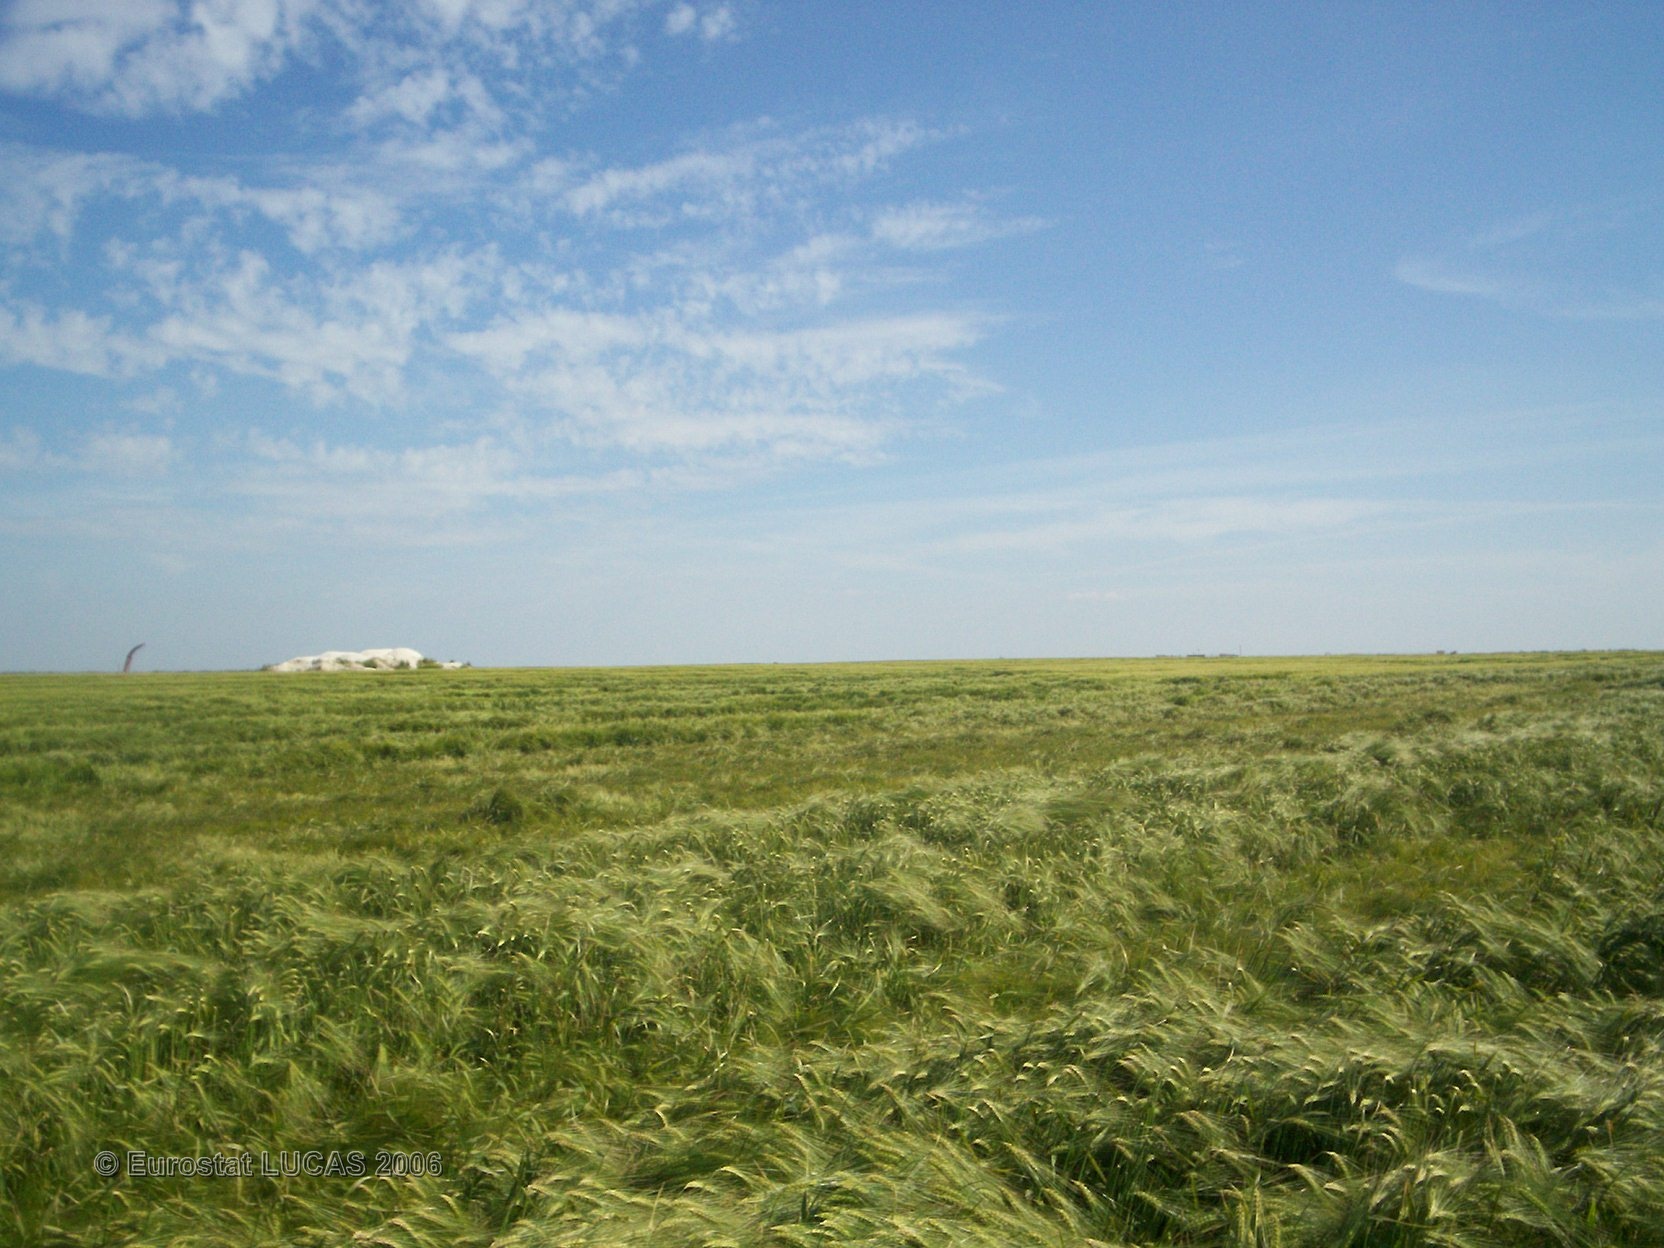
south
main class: Cropland
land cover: Barley
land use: Agriculture (excluding fallow land and kitchen gardens)
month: June
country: FR
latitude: 49.5495
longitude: 2.6493
